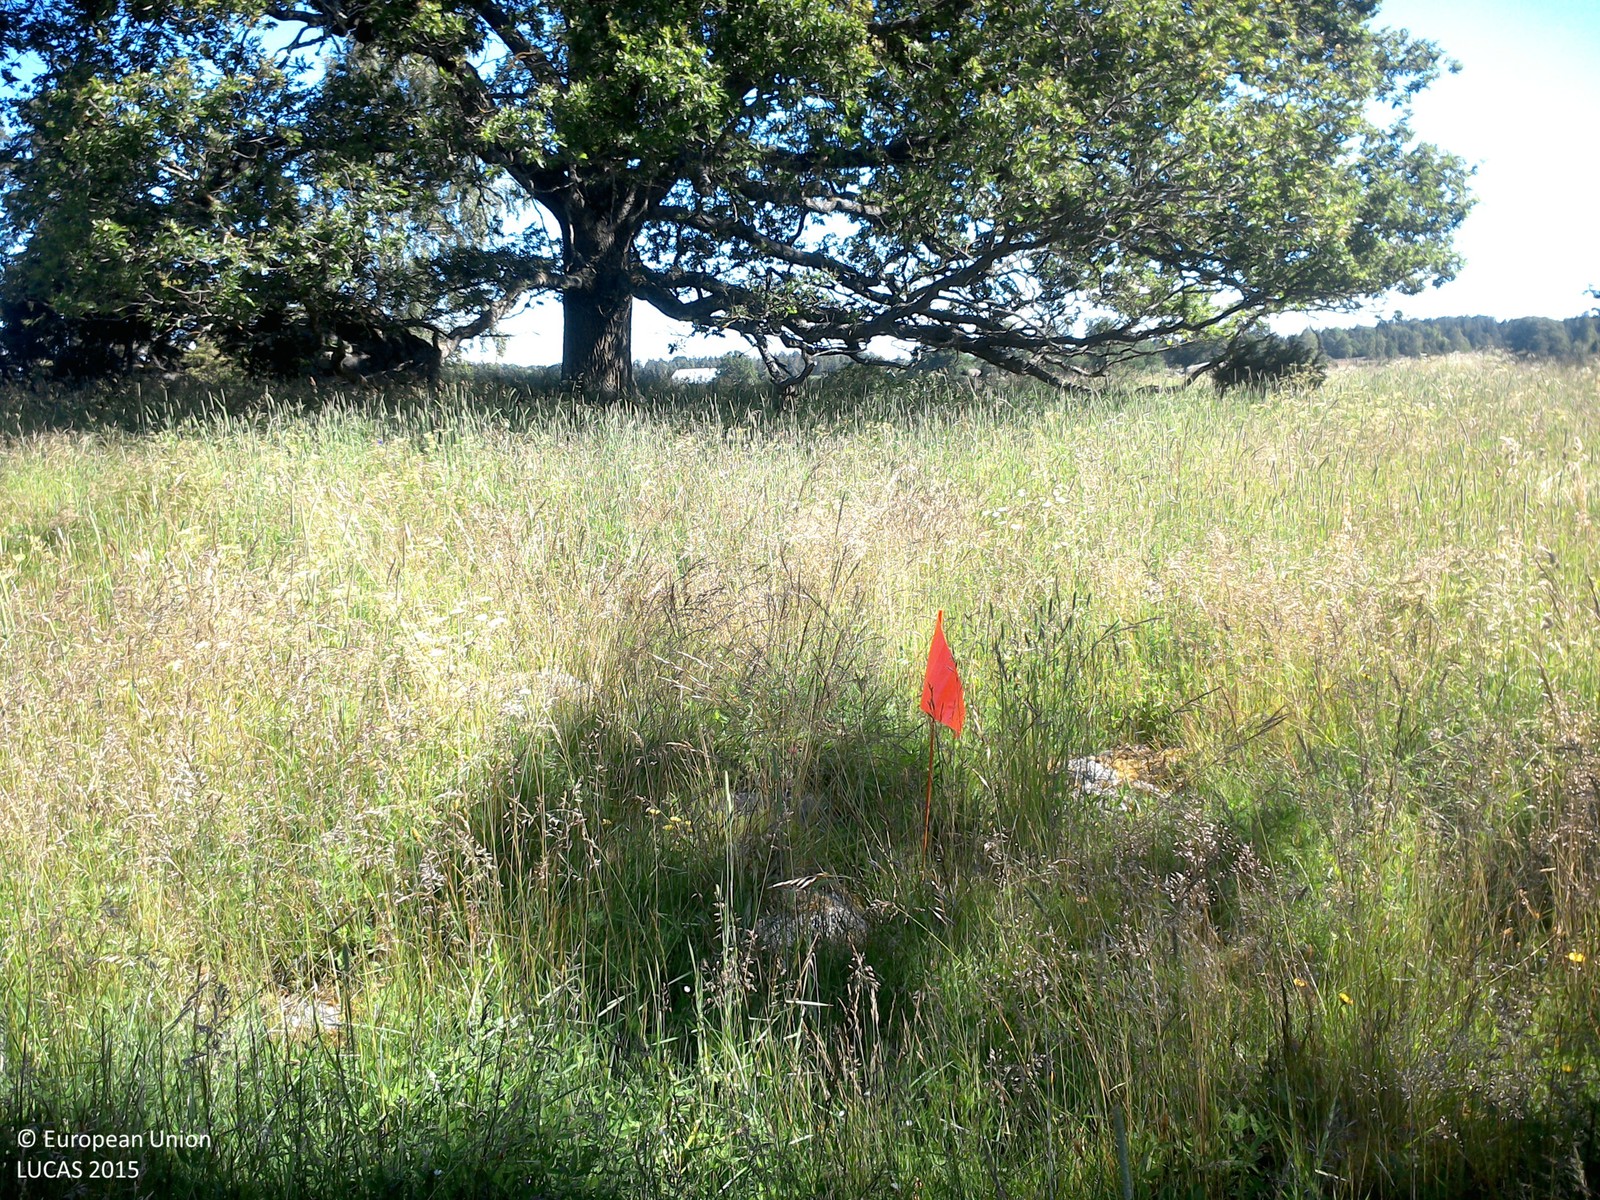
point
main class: Grassland
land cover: Grassland with sparse tree/shrub cover
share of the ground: > 75 %
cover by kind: herbaceous plants 95 %, broadleaved forest trees 5 %
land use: Agriculture (excluding fallow land and kitchen gardens)
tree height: > 5 m
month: July
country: SE
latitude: 58.4016
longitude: 15.3501
